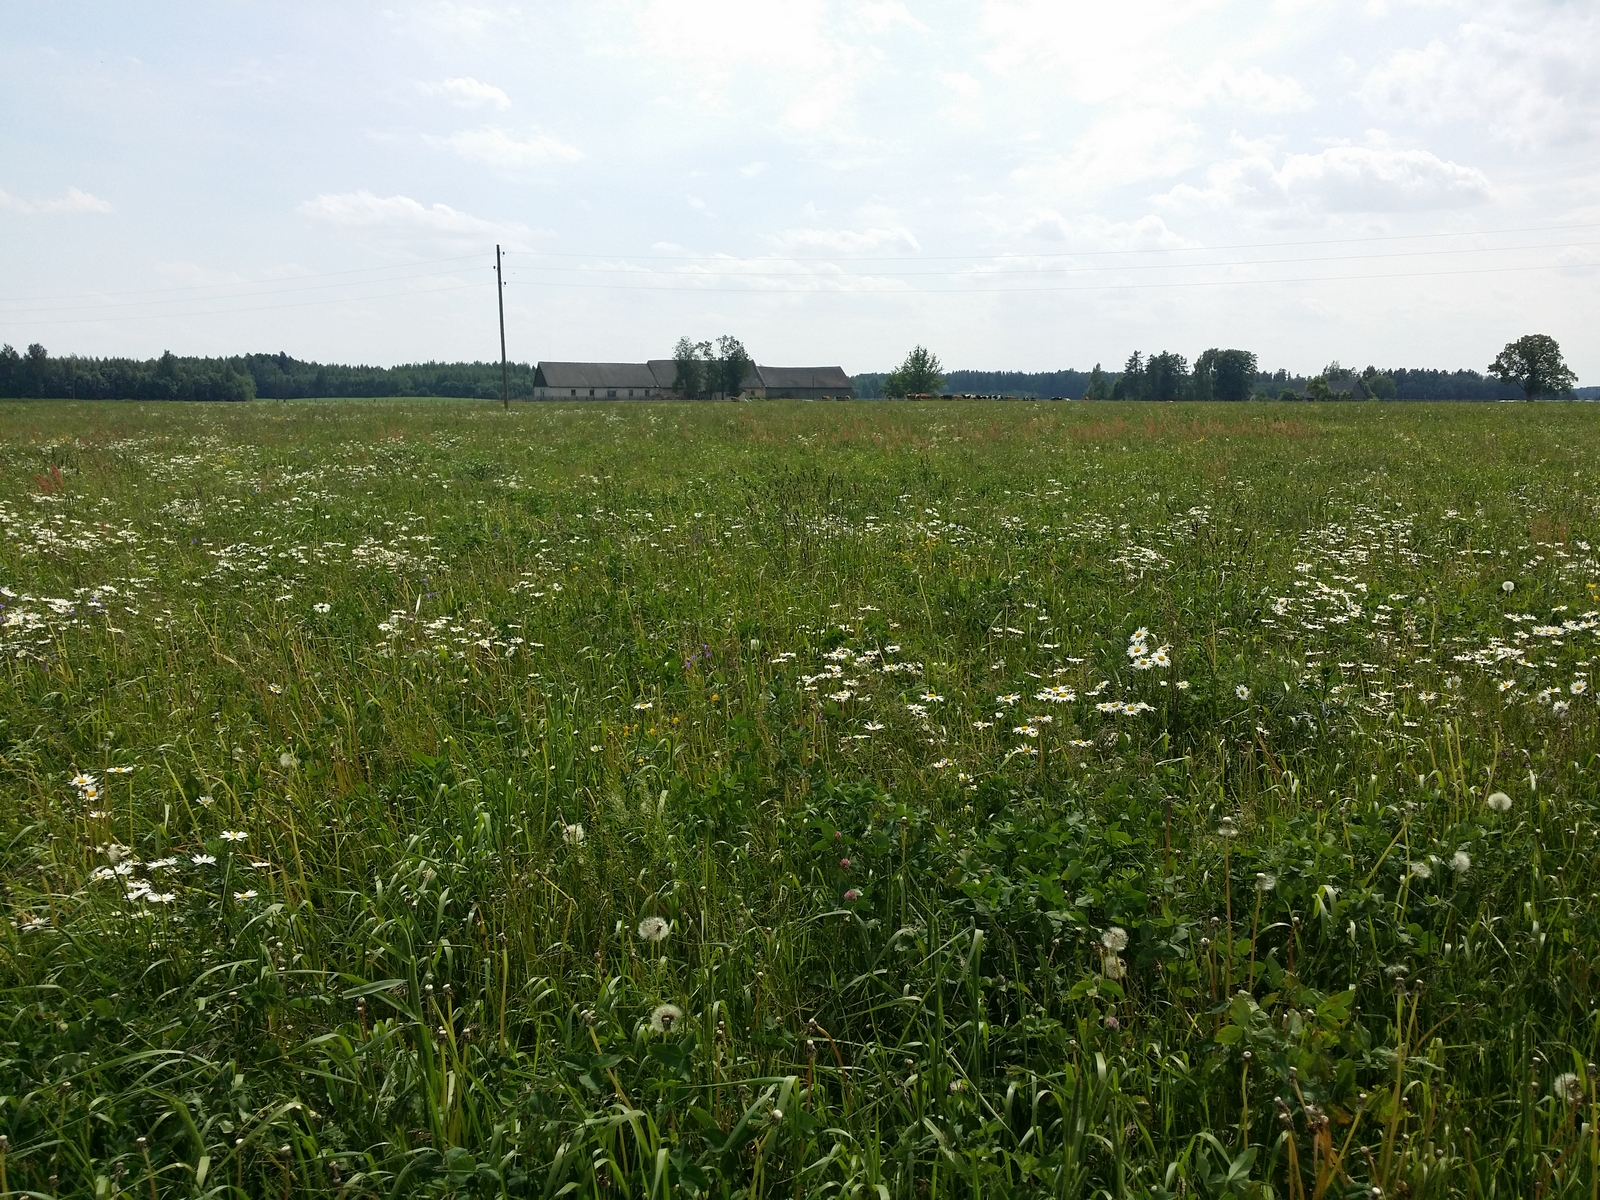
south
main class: Grassland
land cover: Grassland without tree/shrub cover
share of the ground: > 75 %
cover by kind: herbaceous plants 100 %
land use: Agriculture (excluding fallow land and kitchen gardens)
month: June
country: LV
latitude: 57.4354
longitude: 26.5868
